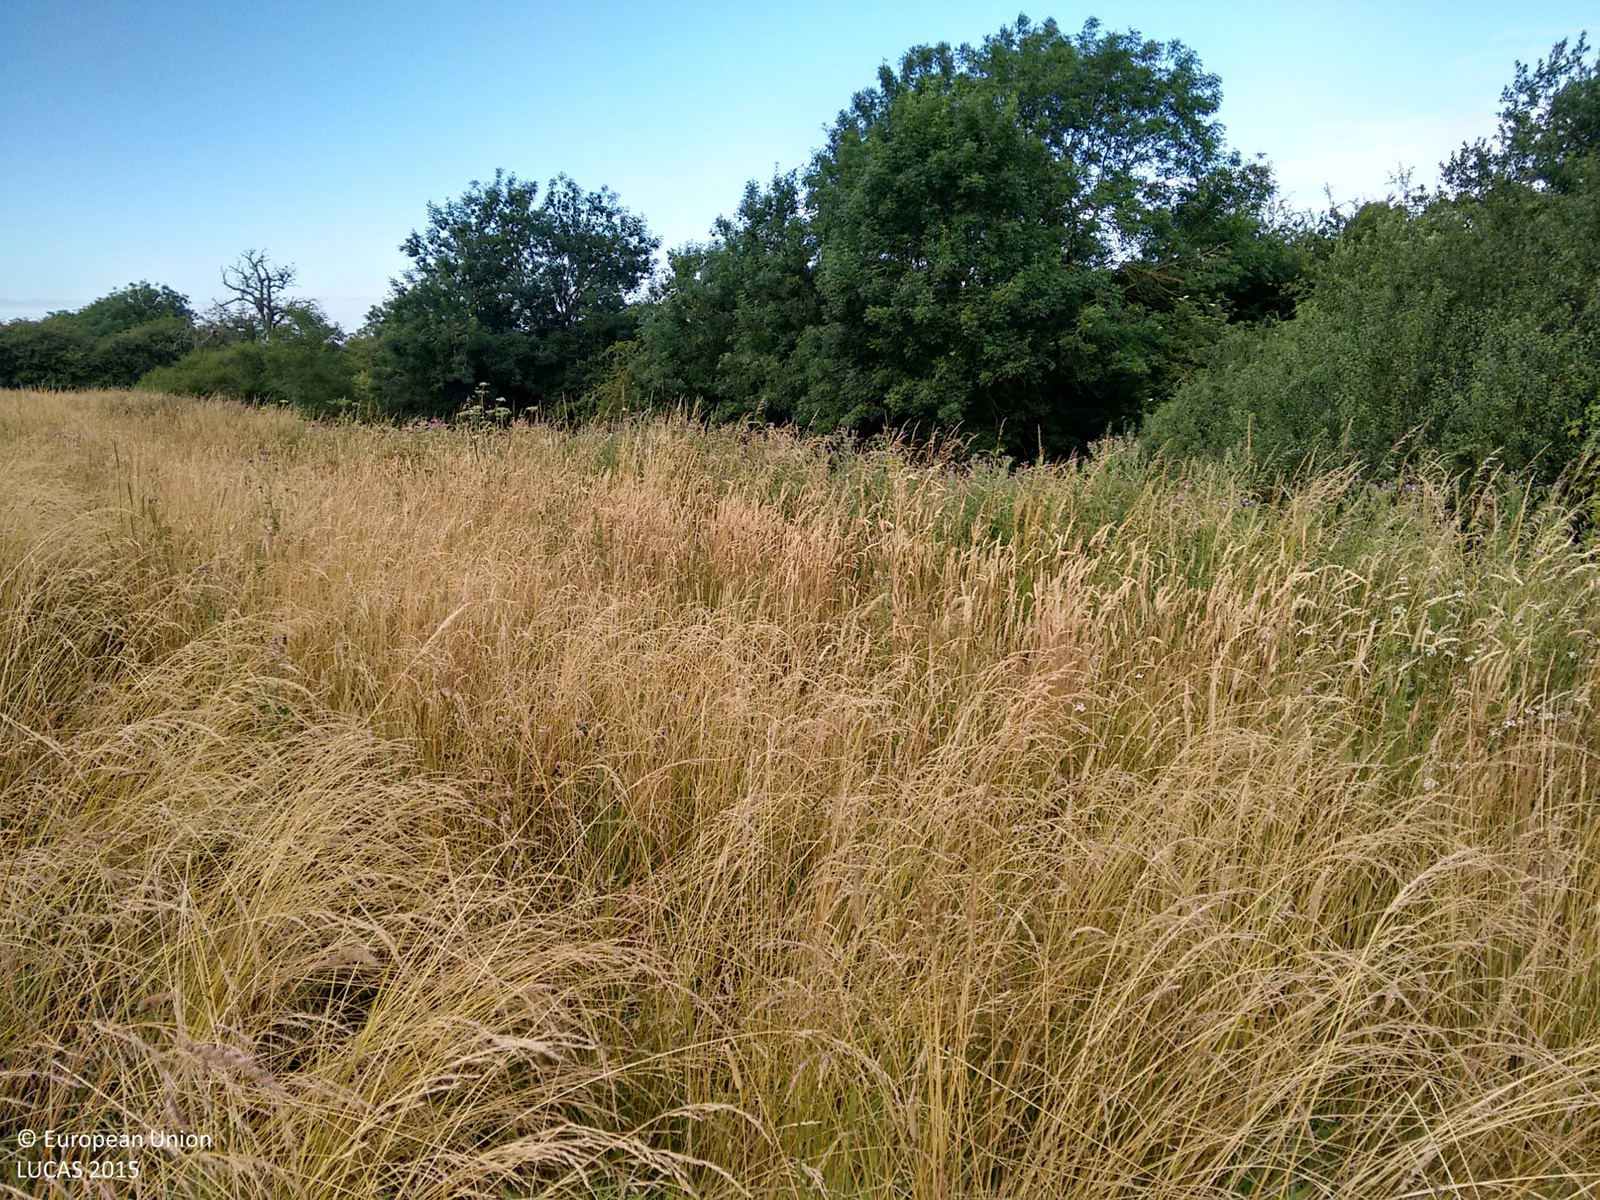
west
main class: Grassland
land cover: Grassland with sparse tree/shrub cover
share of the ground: > 75 %
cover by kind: herbaceous plants 95 %, broadleaved forest trees 5 %
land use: Agriculture (excluding fallow land and kitchen gardens)
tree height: < 5 m
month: July
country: GB
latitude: 52.6766
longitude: -0.8539
